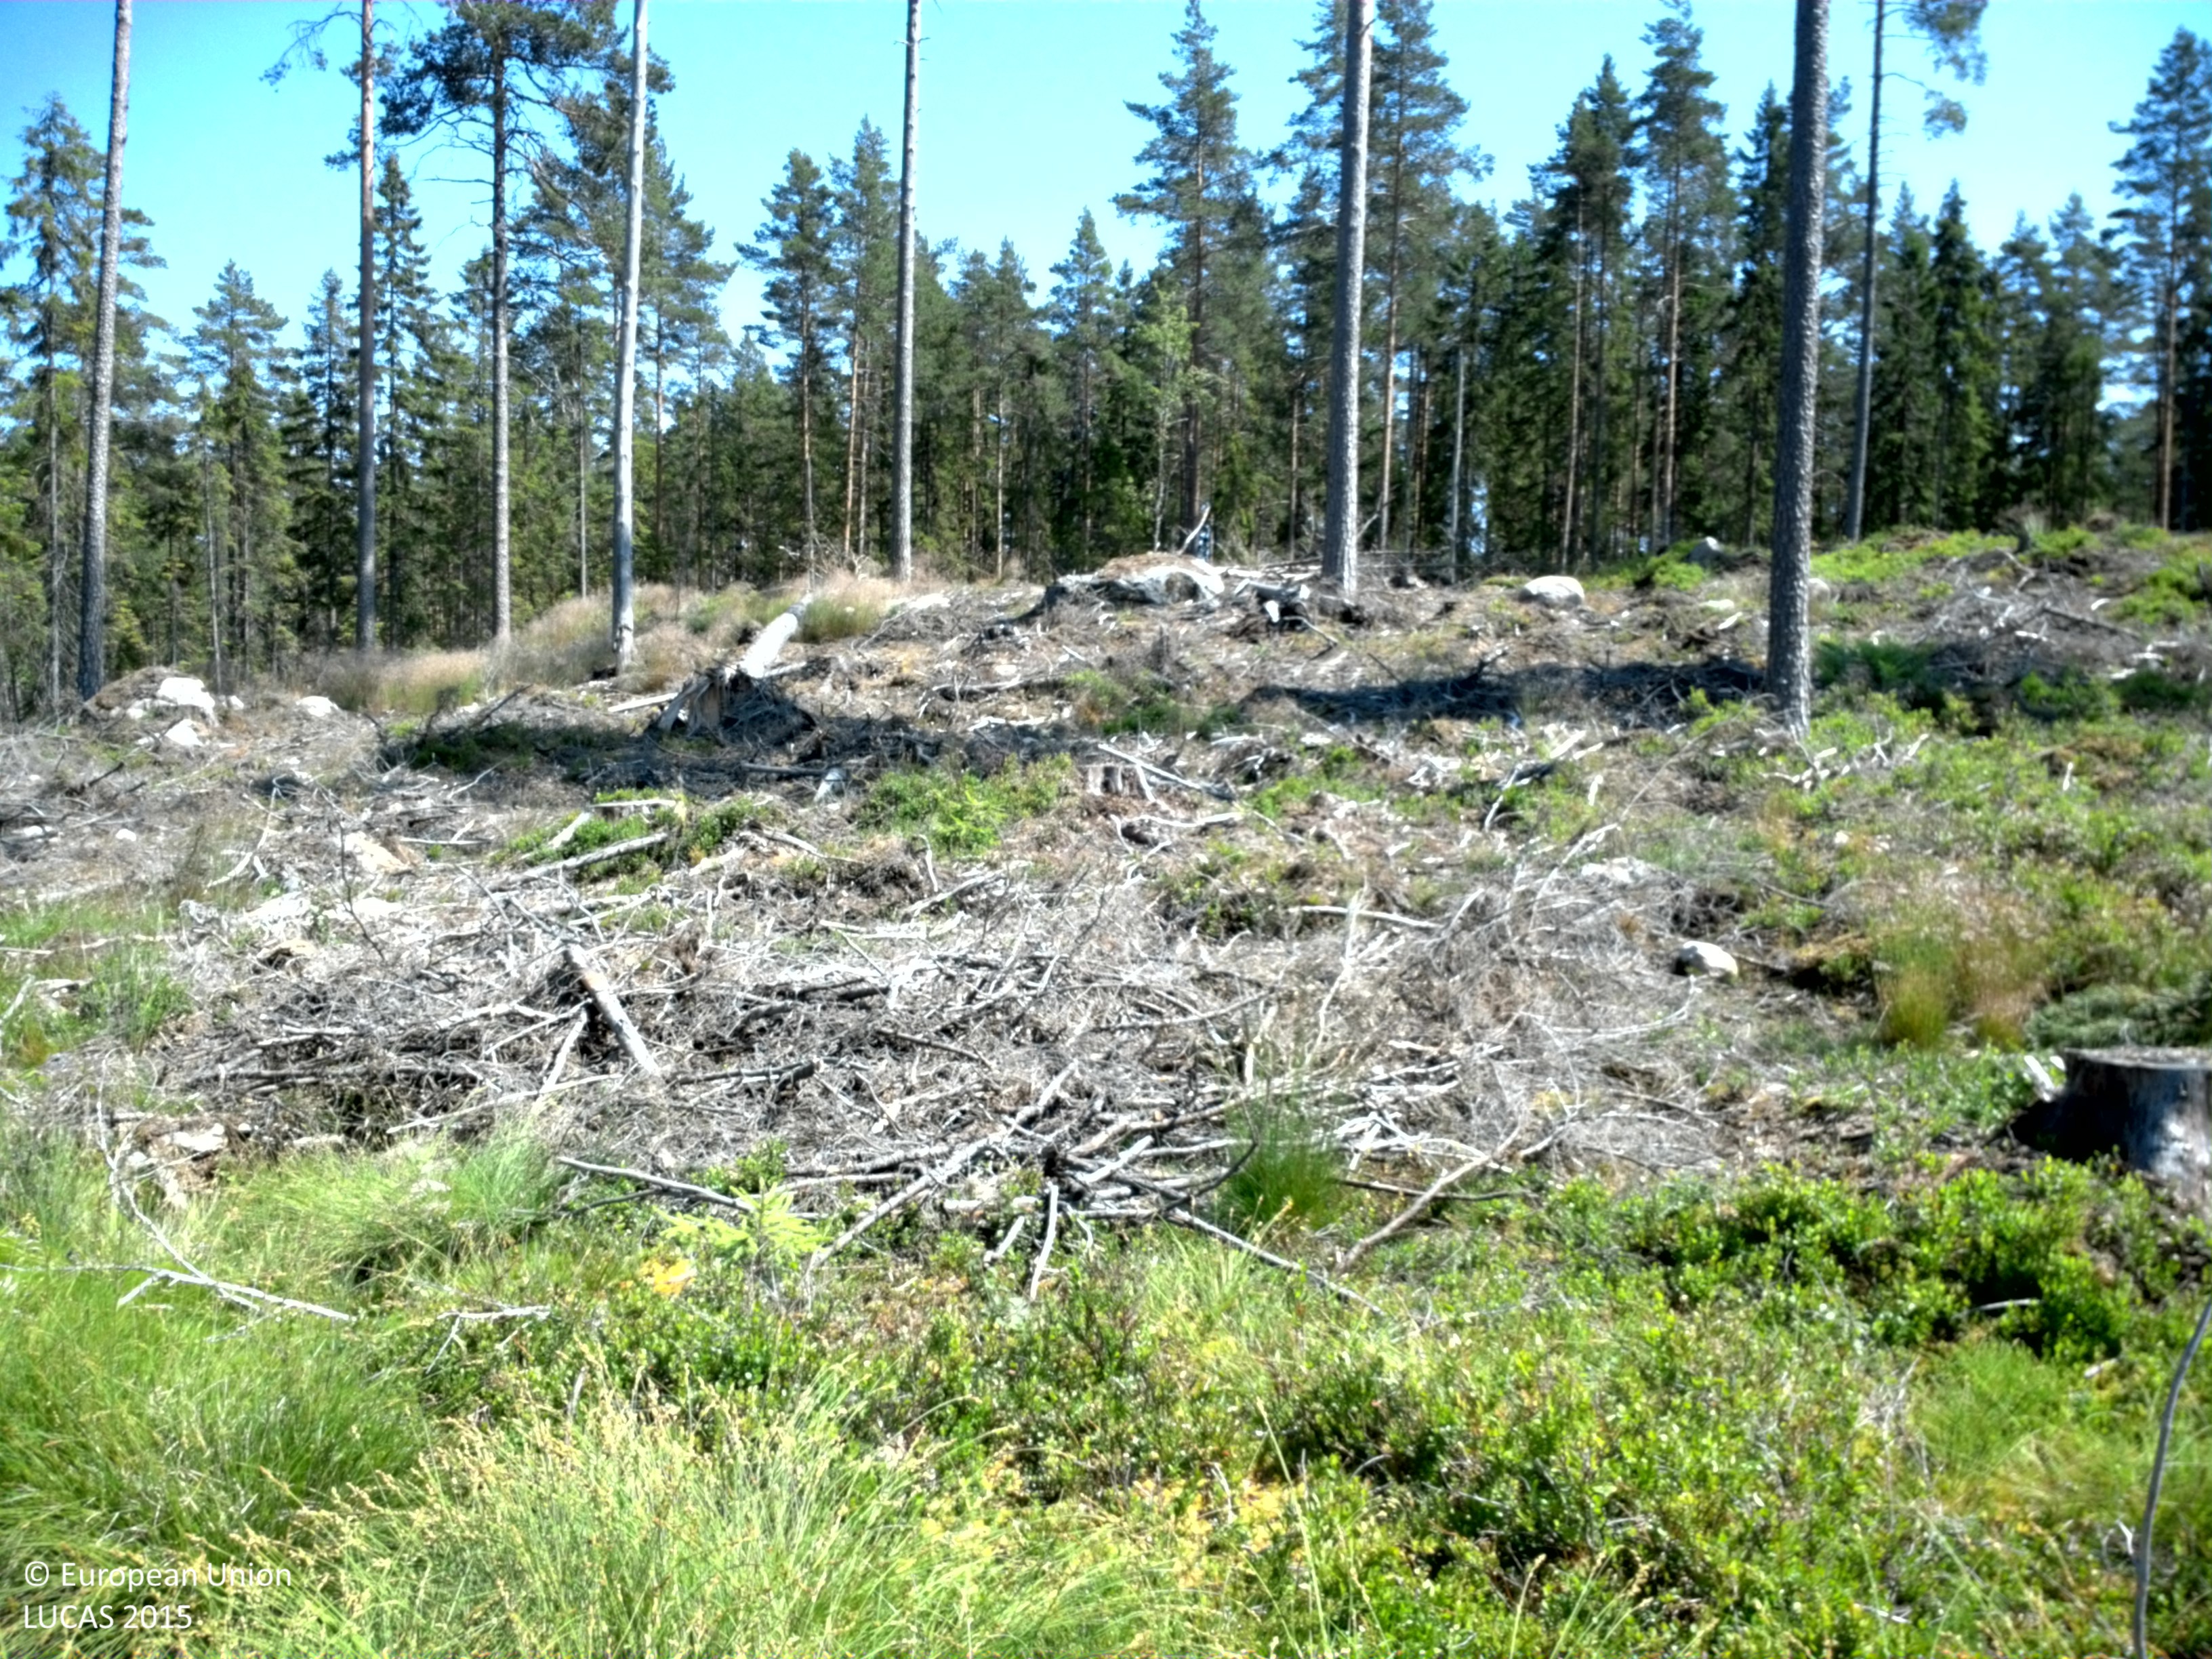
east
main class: Woodland
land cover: Pine dominated coniferous woodland
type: boreal forest
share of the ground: 10 - 25 %
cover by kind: herbaceous plants 60 %, lichens and mosses 30 %, coniferous forest trees 10 %
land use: Forestry
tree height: > 5 m
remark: Clear cut
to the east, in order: Pine dominated coniferous woodland; Tracks; Pine dominated coniferous woodland; Inland fresh water bodies
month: July
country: SE
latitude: 58.7712
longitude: 14.6100
